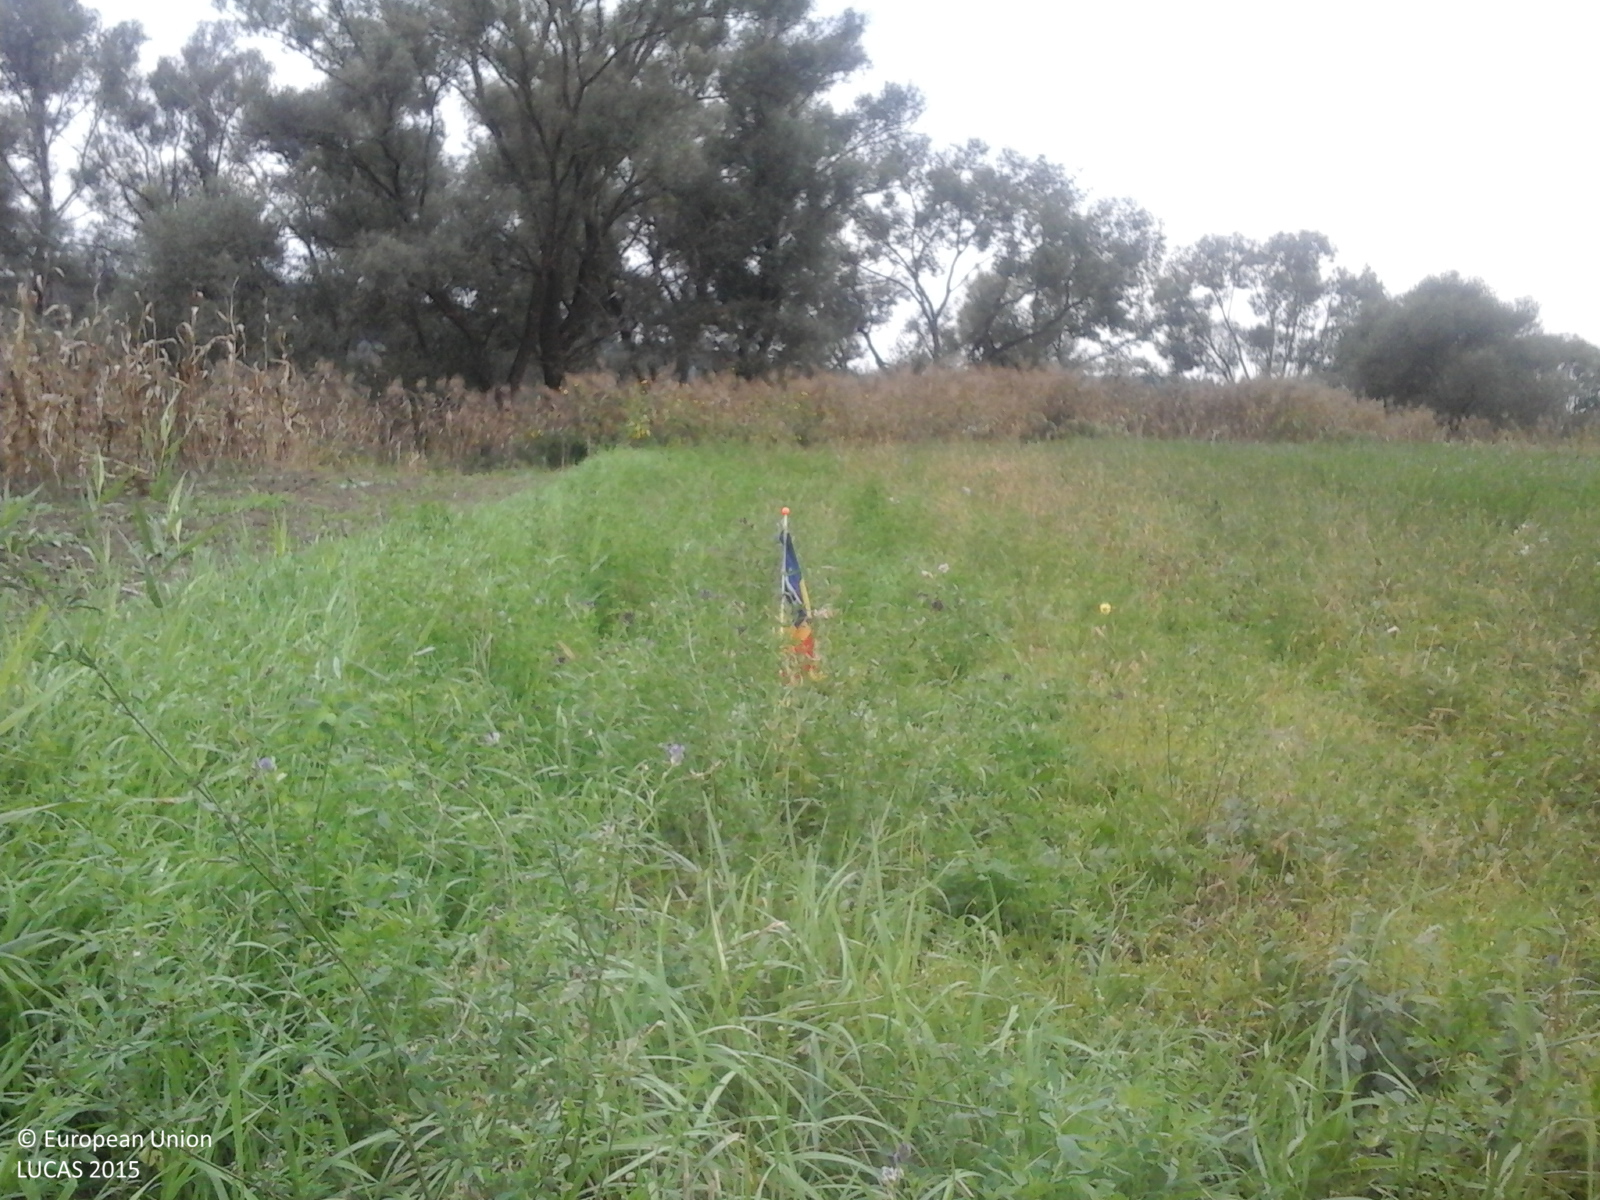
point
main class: Cropland
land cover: Lucerne
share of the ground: > 75 %
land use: Agriculture (excluding fallow land and kitchen gardens)
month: October
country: RO
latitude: 46.4152
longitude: 24.7804
